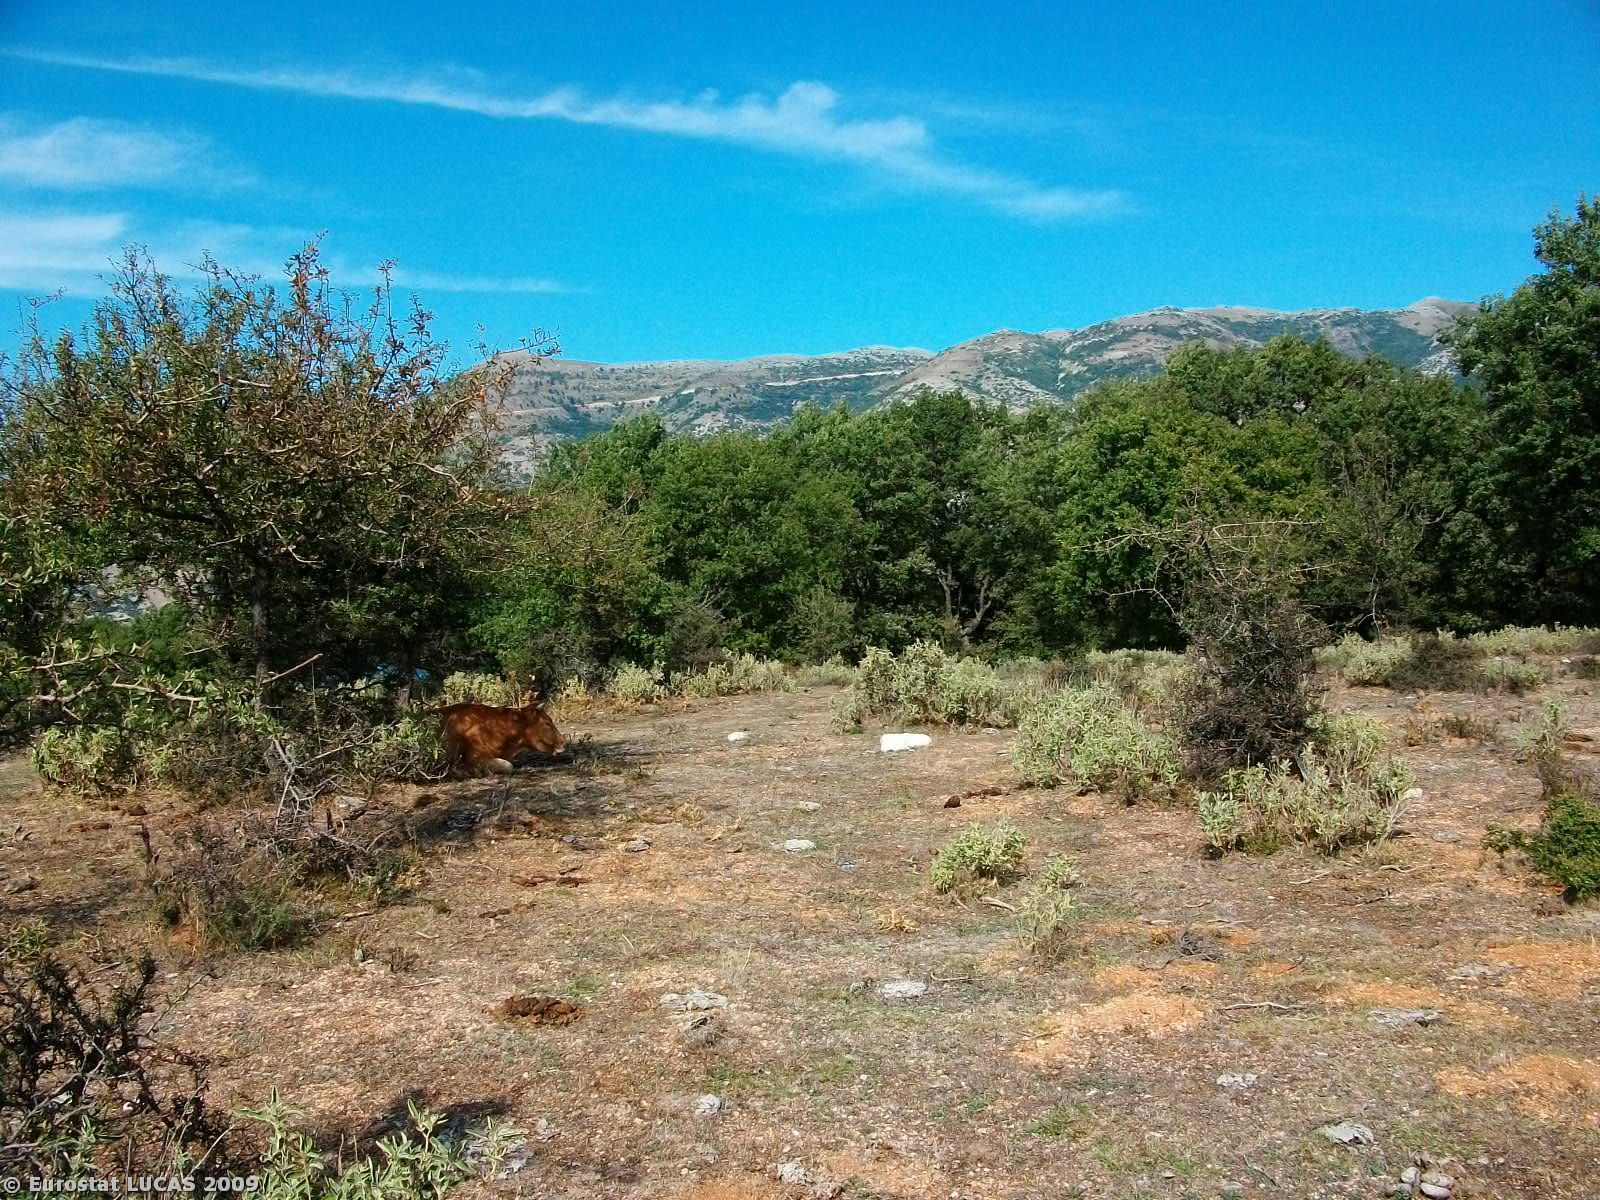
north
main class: Grassland
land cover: Grassland with sparse tree/shrub cover
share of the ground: > 75 %
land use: Agriculture (excluding fallow land and kitchen gardens)
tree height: < 5 m
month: September
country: GR
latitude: 39.6365
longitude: 20.2637
